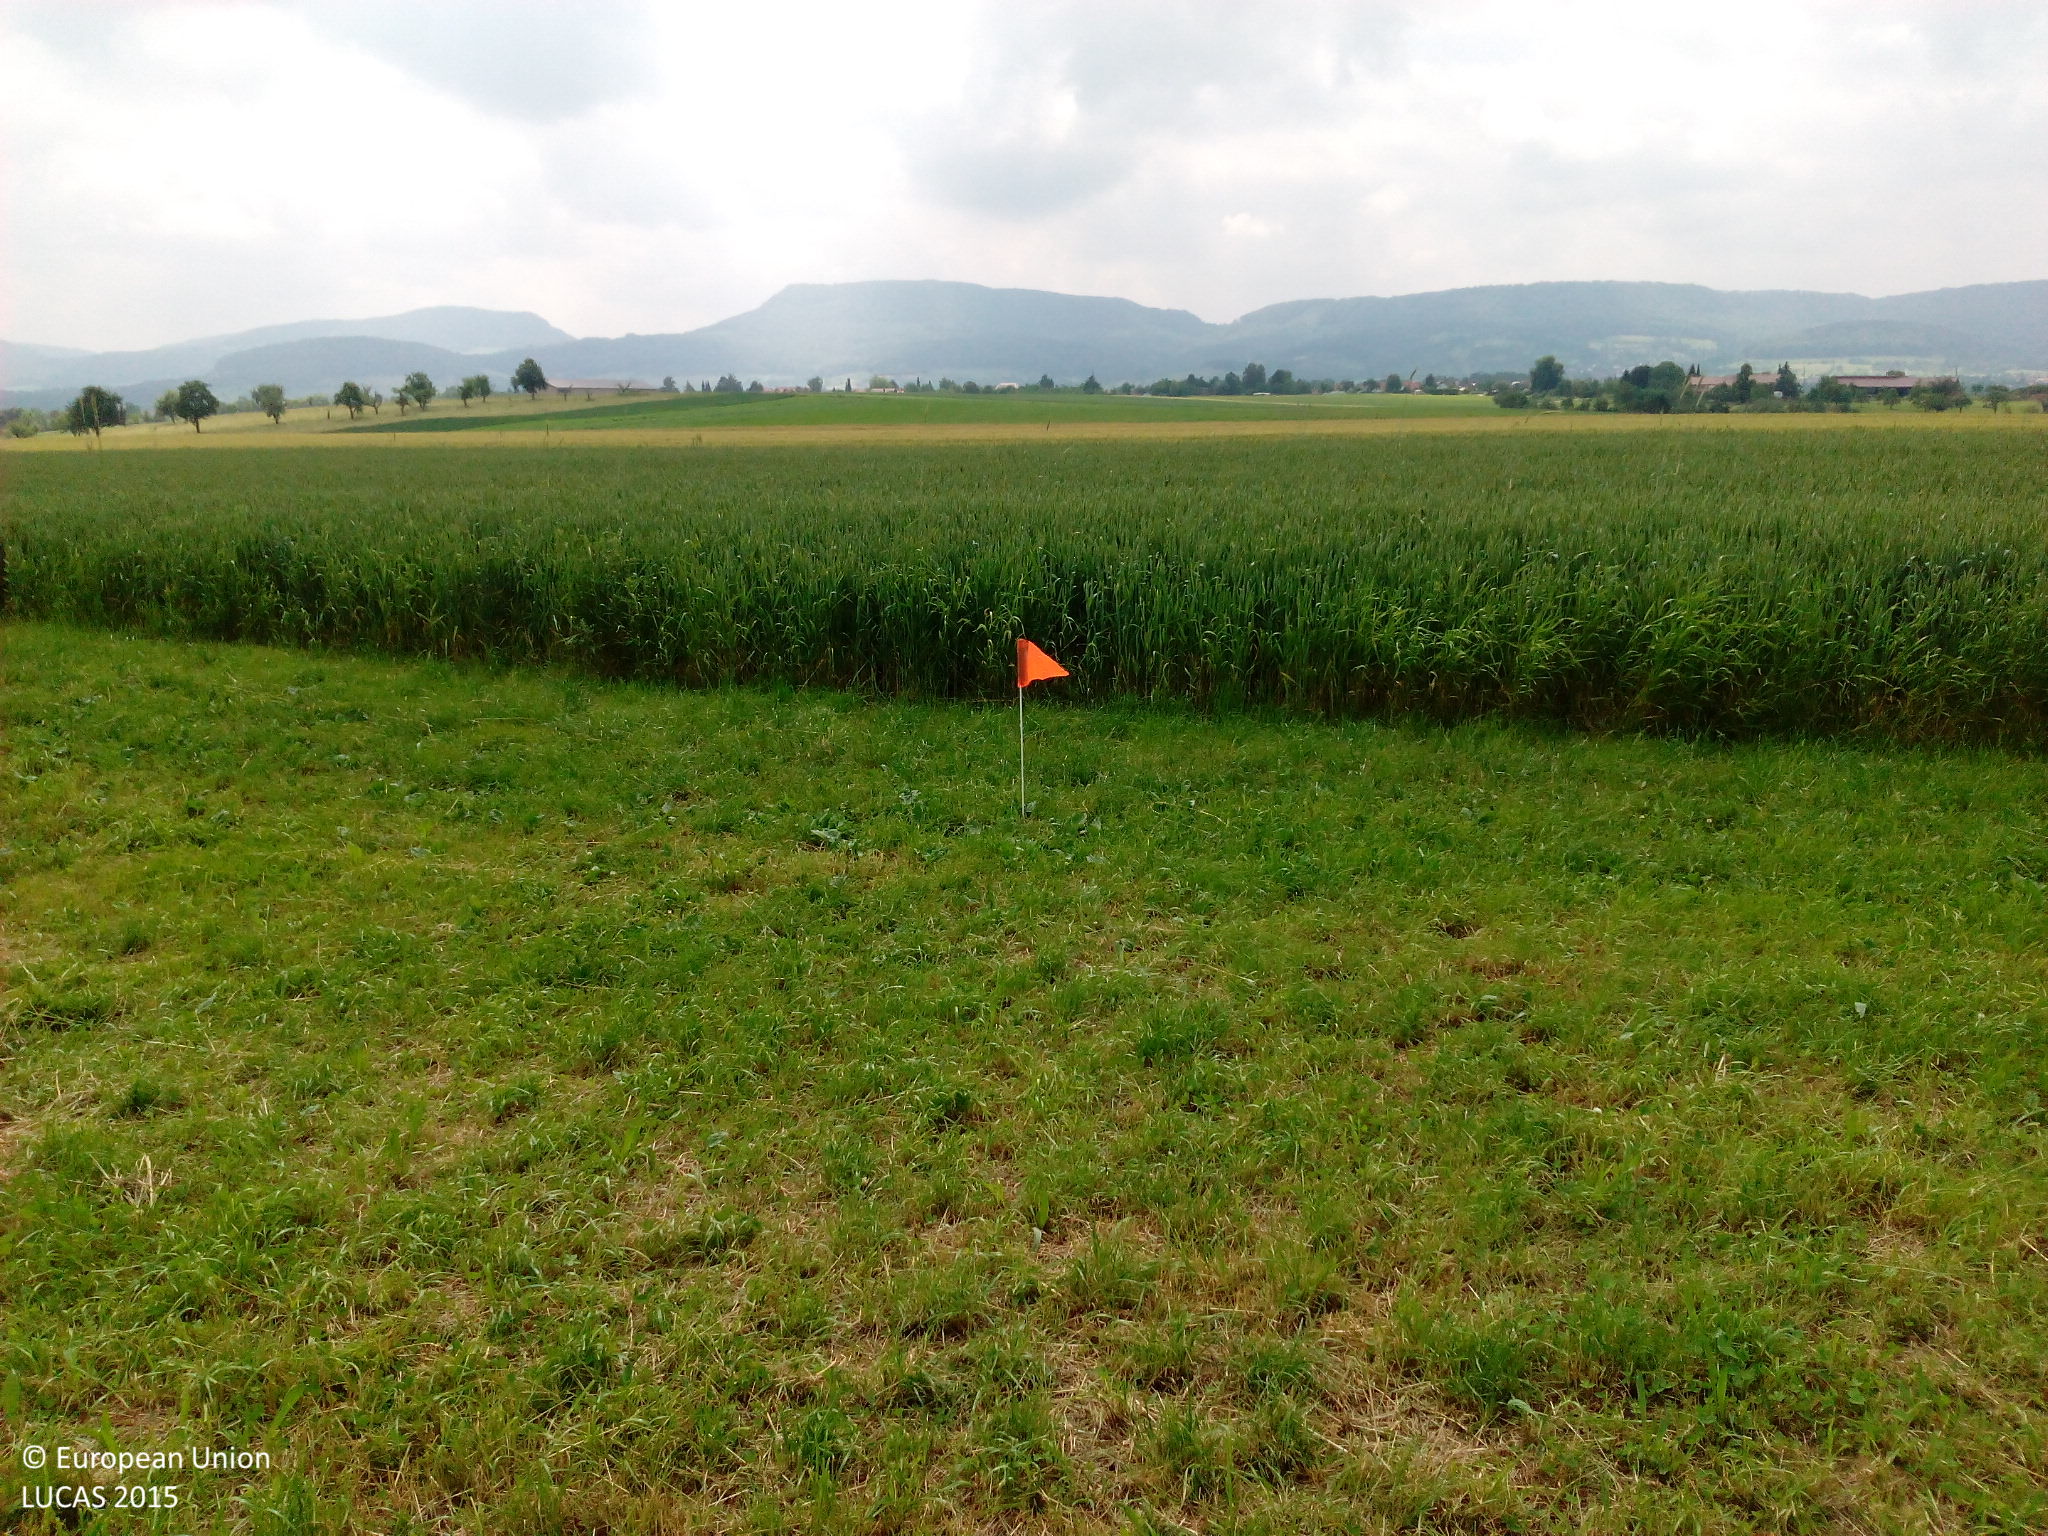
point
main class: Grassland
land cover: Grassland without tree/shrub cover
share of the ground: > 75 %
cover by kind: herbaceous plants 100 %
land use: Agriculture (excluding fallow land and kitchen gardens)
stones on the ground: < 10 %
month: June
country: DE
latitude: 48.6728
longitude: 9.6335
